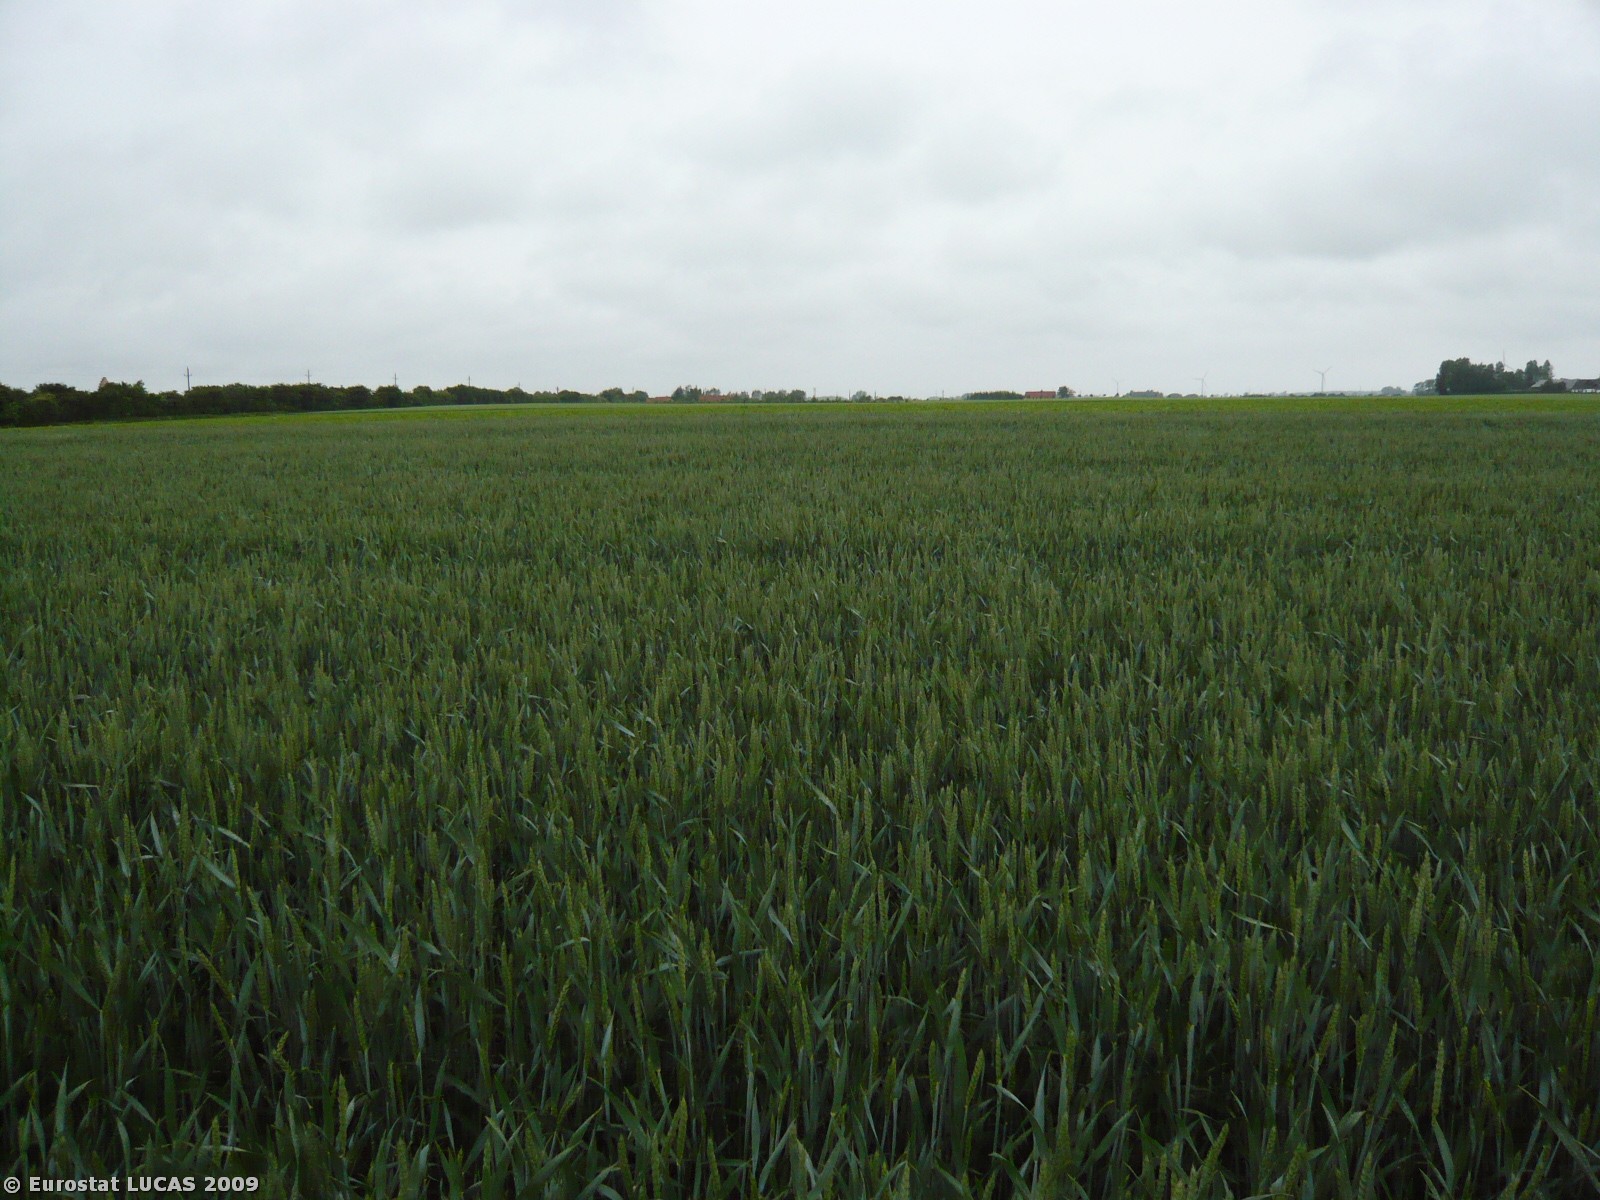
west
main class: Cropland
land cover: Common wheat
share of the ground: > 75 %
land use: Agriculture (excluding fallow land and kitchen gardens)
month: June
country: DK
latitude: 54.8624
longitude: 11.8216
